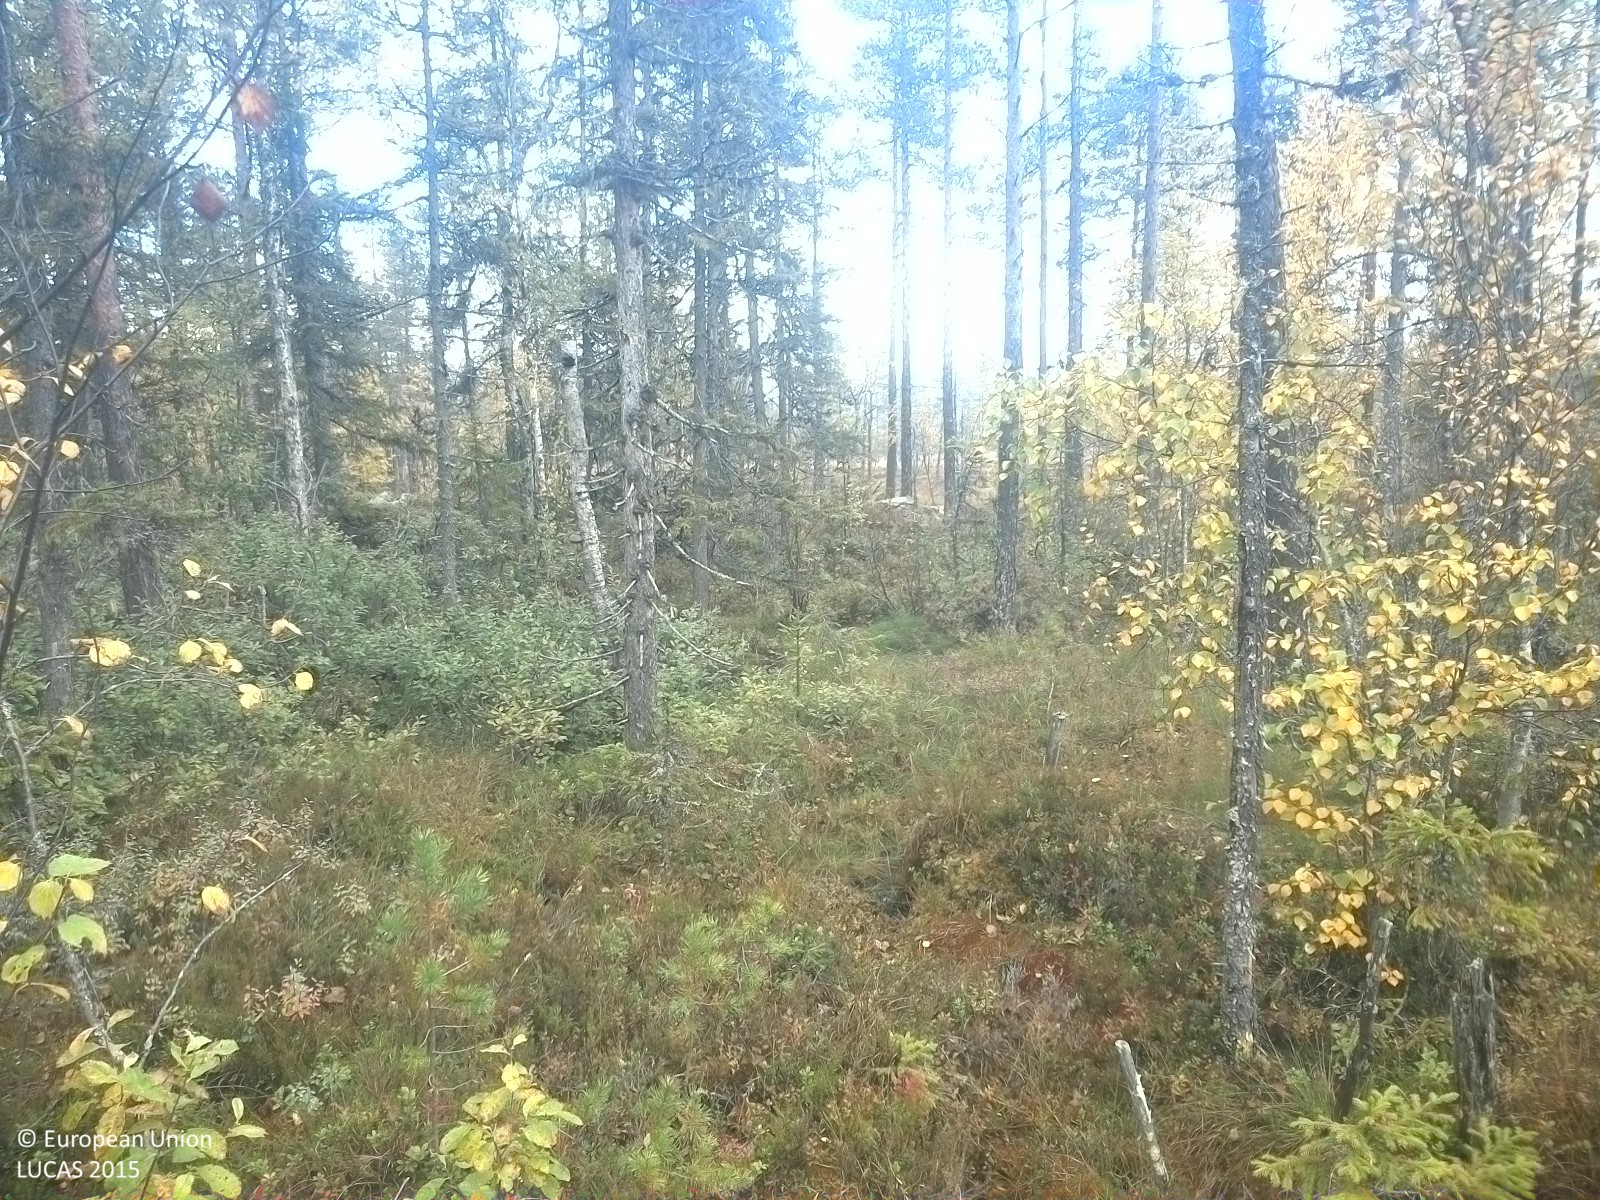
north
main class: Woodland
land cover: Pine dominated mixed woodland
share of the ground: 50 - 75 %
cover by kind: coniferous forest trees 40 %, lichens and mosses 35 %, broadleaved forest trees 15 %, shrubs 10 %
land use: Forestry
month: September
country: SE
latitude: 62.1272
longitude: 15.6375
